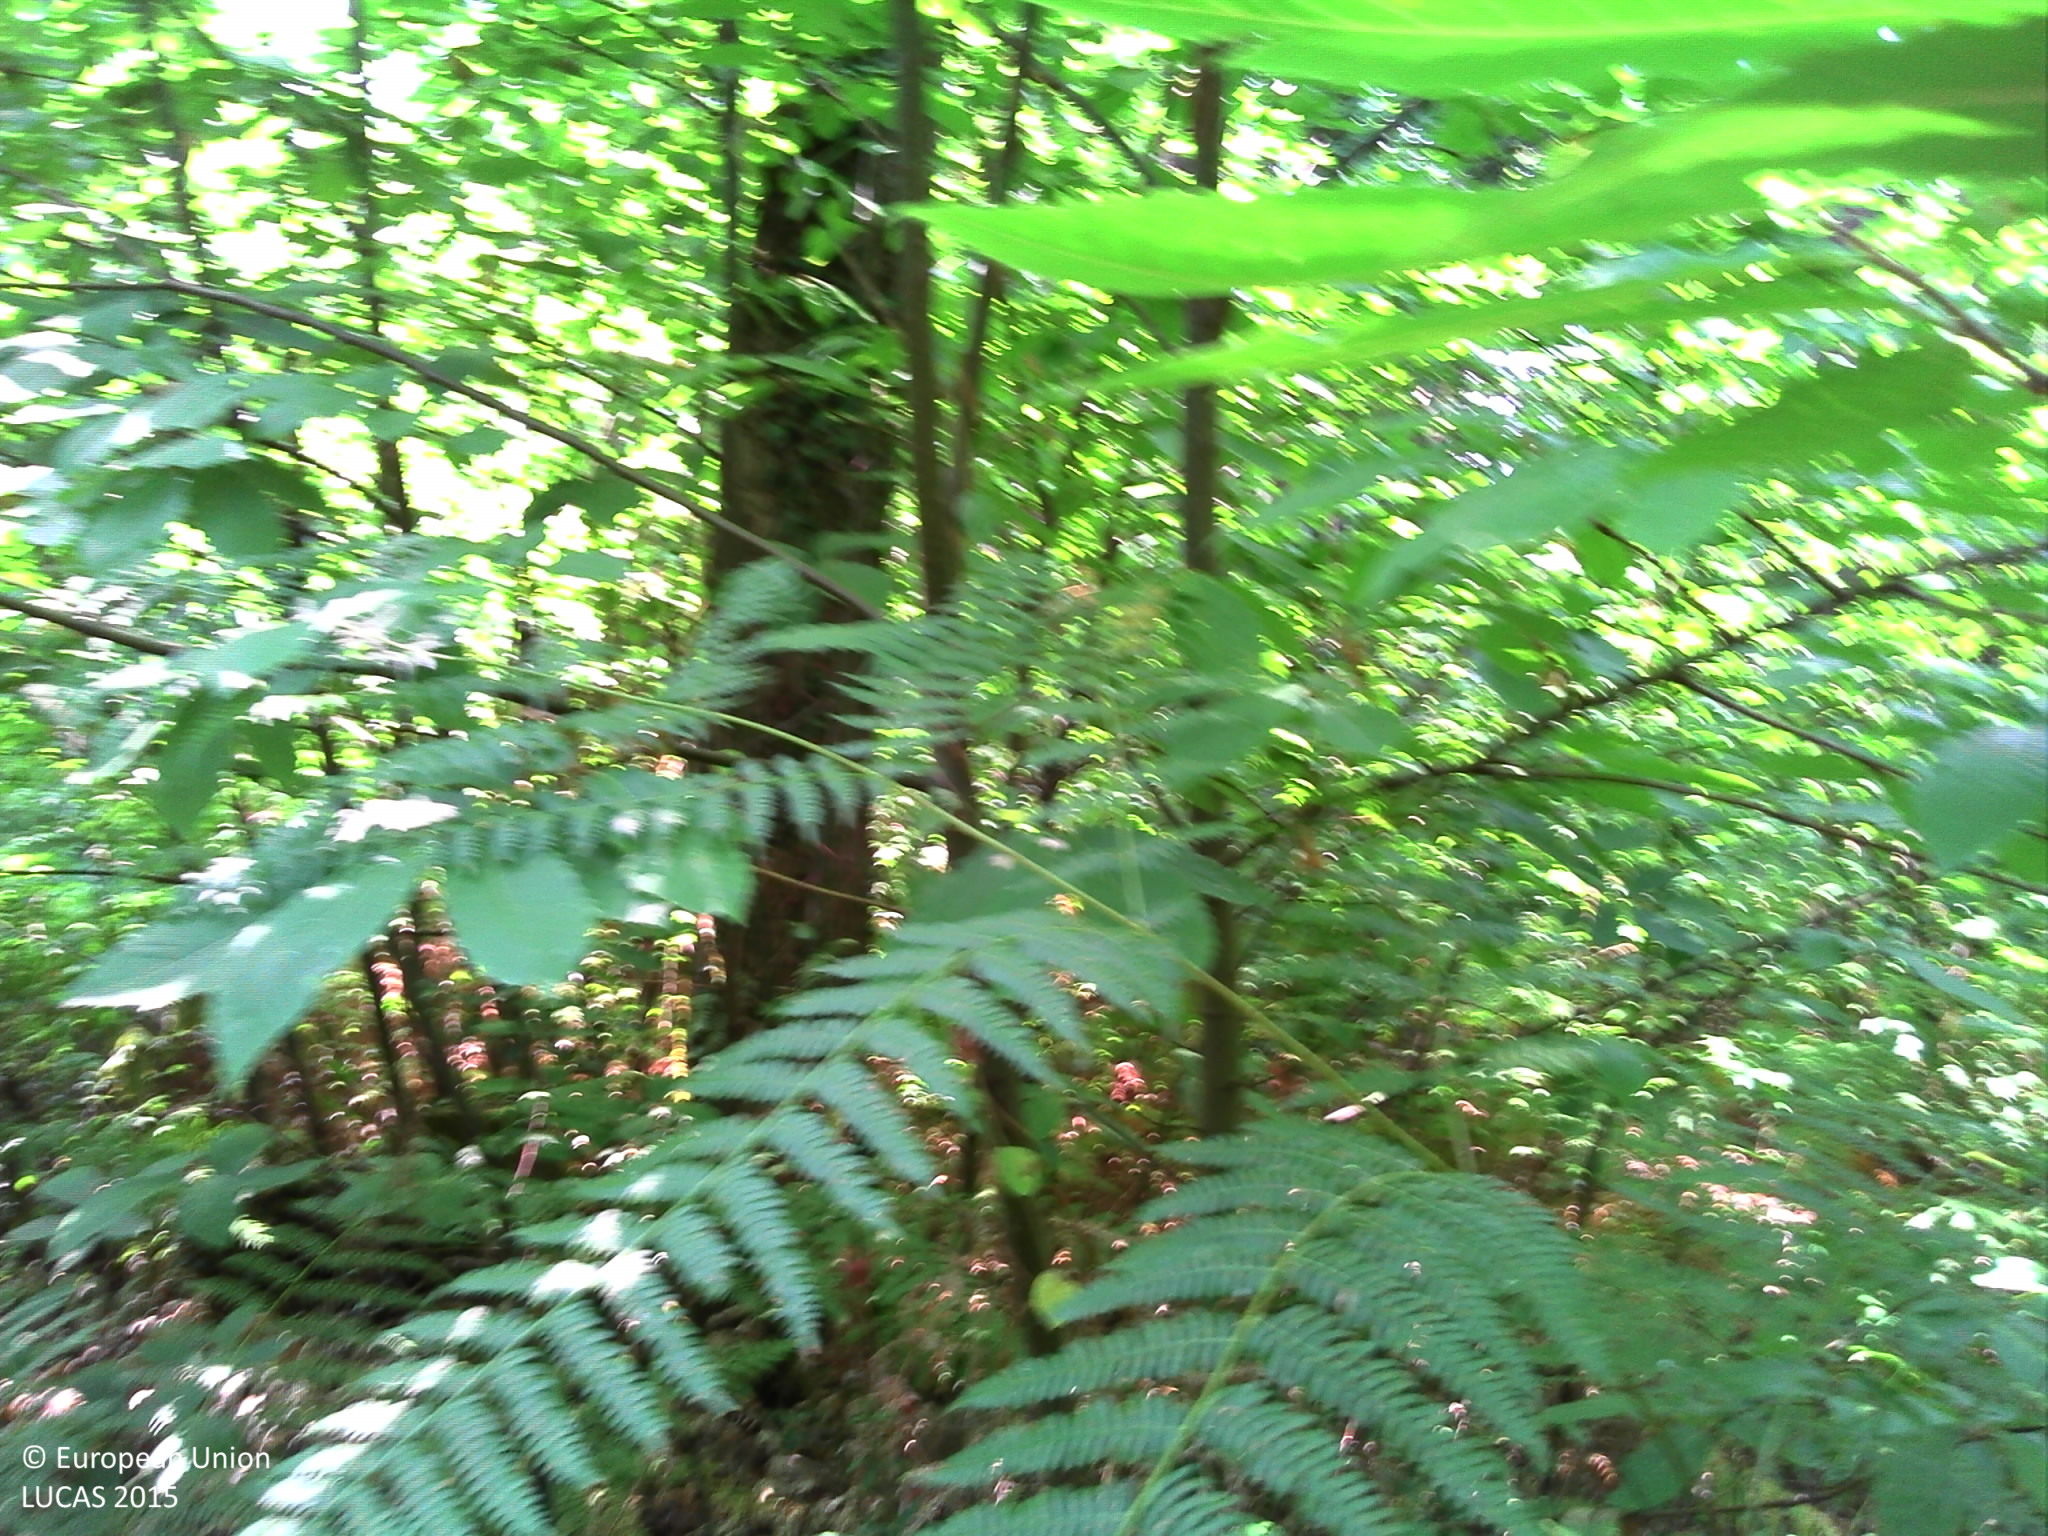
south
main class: Woodland
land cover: Broadleaved woodland
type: thermophilous deciduous forest
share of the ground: > 75 %
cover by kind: broadleaved forest trees 70 %, shrubs 15 %, herbaceous plants 15 %
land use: Forestry
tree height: > 5 m
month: July
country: FR
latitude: 45.1469
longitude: 0.6930
